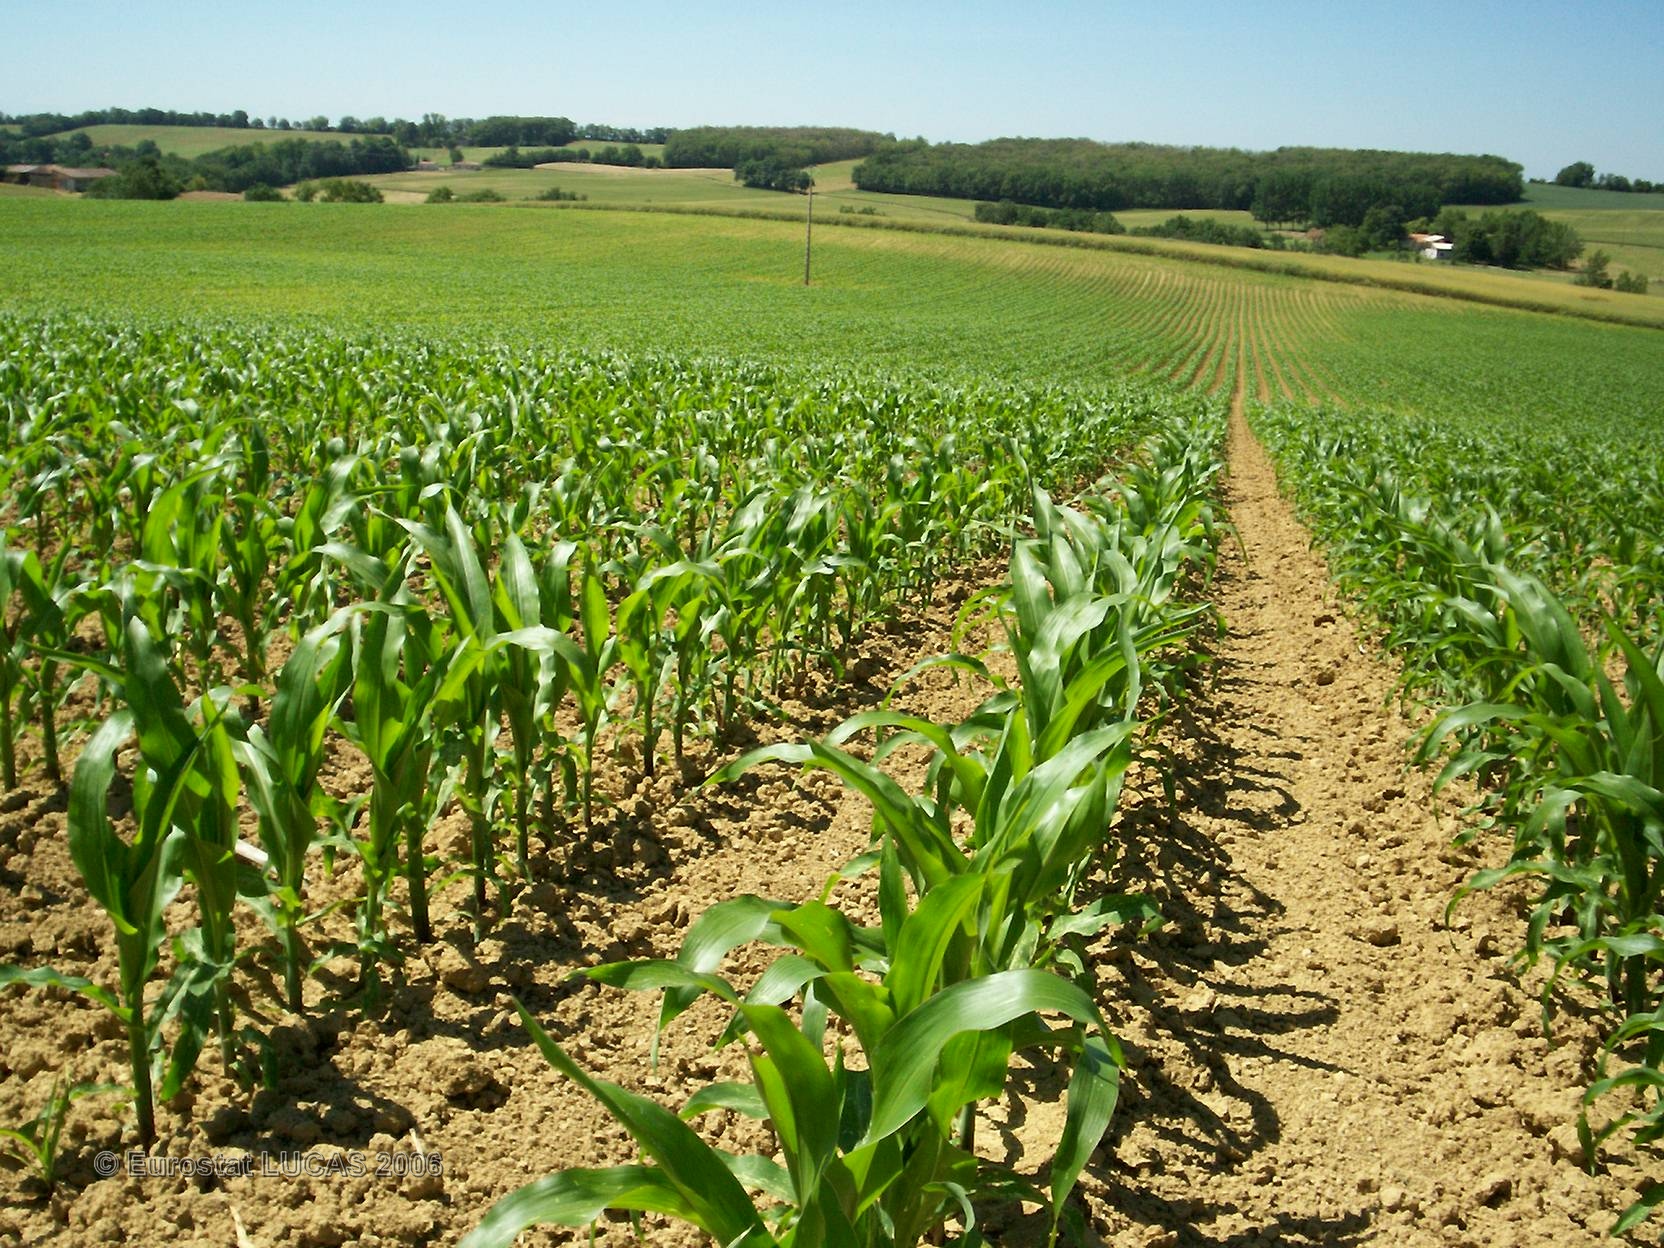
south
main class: Cropland
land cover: Maize
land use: Agriculture (excluding fallow land and kitchen gardens)
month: June
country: FR
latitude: 43.7256
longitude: 0.8249
